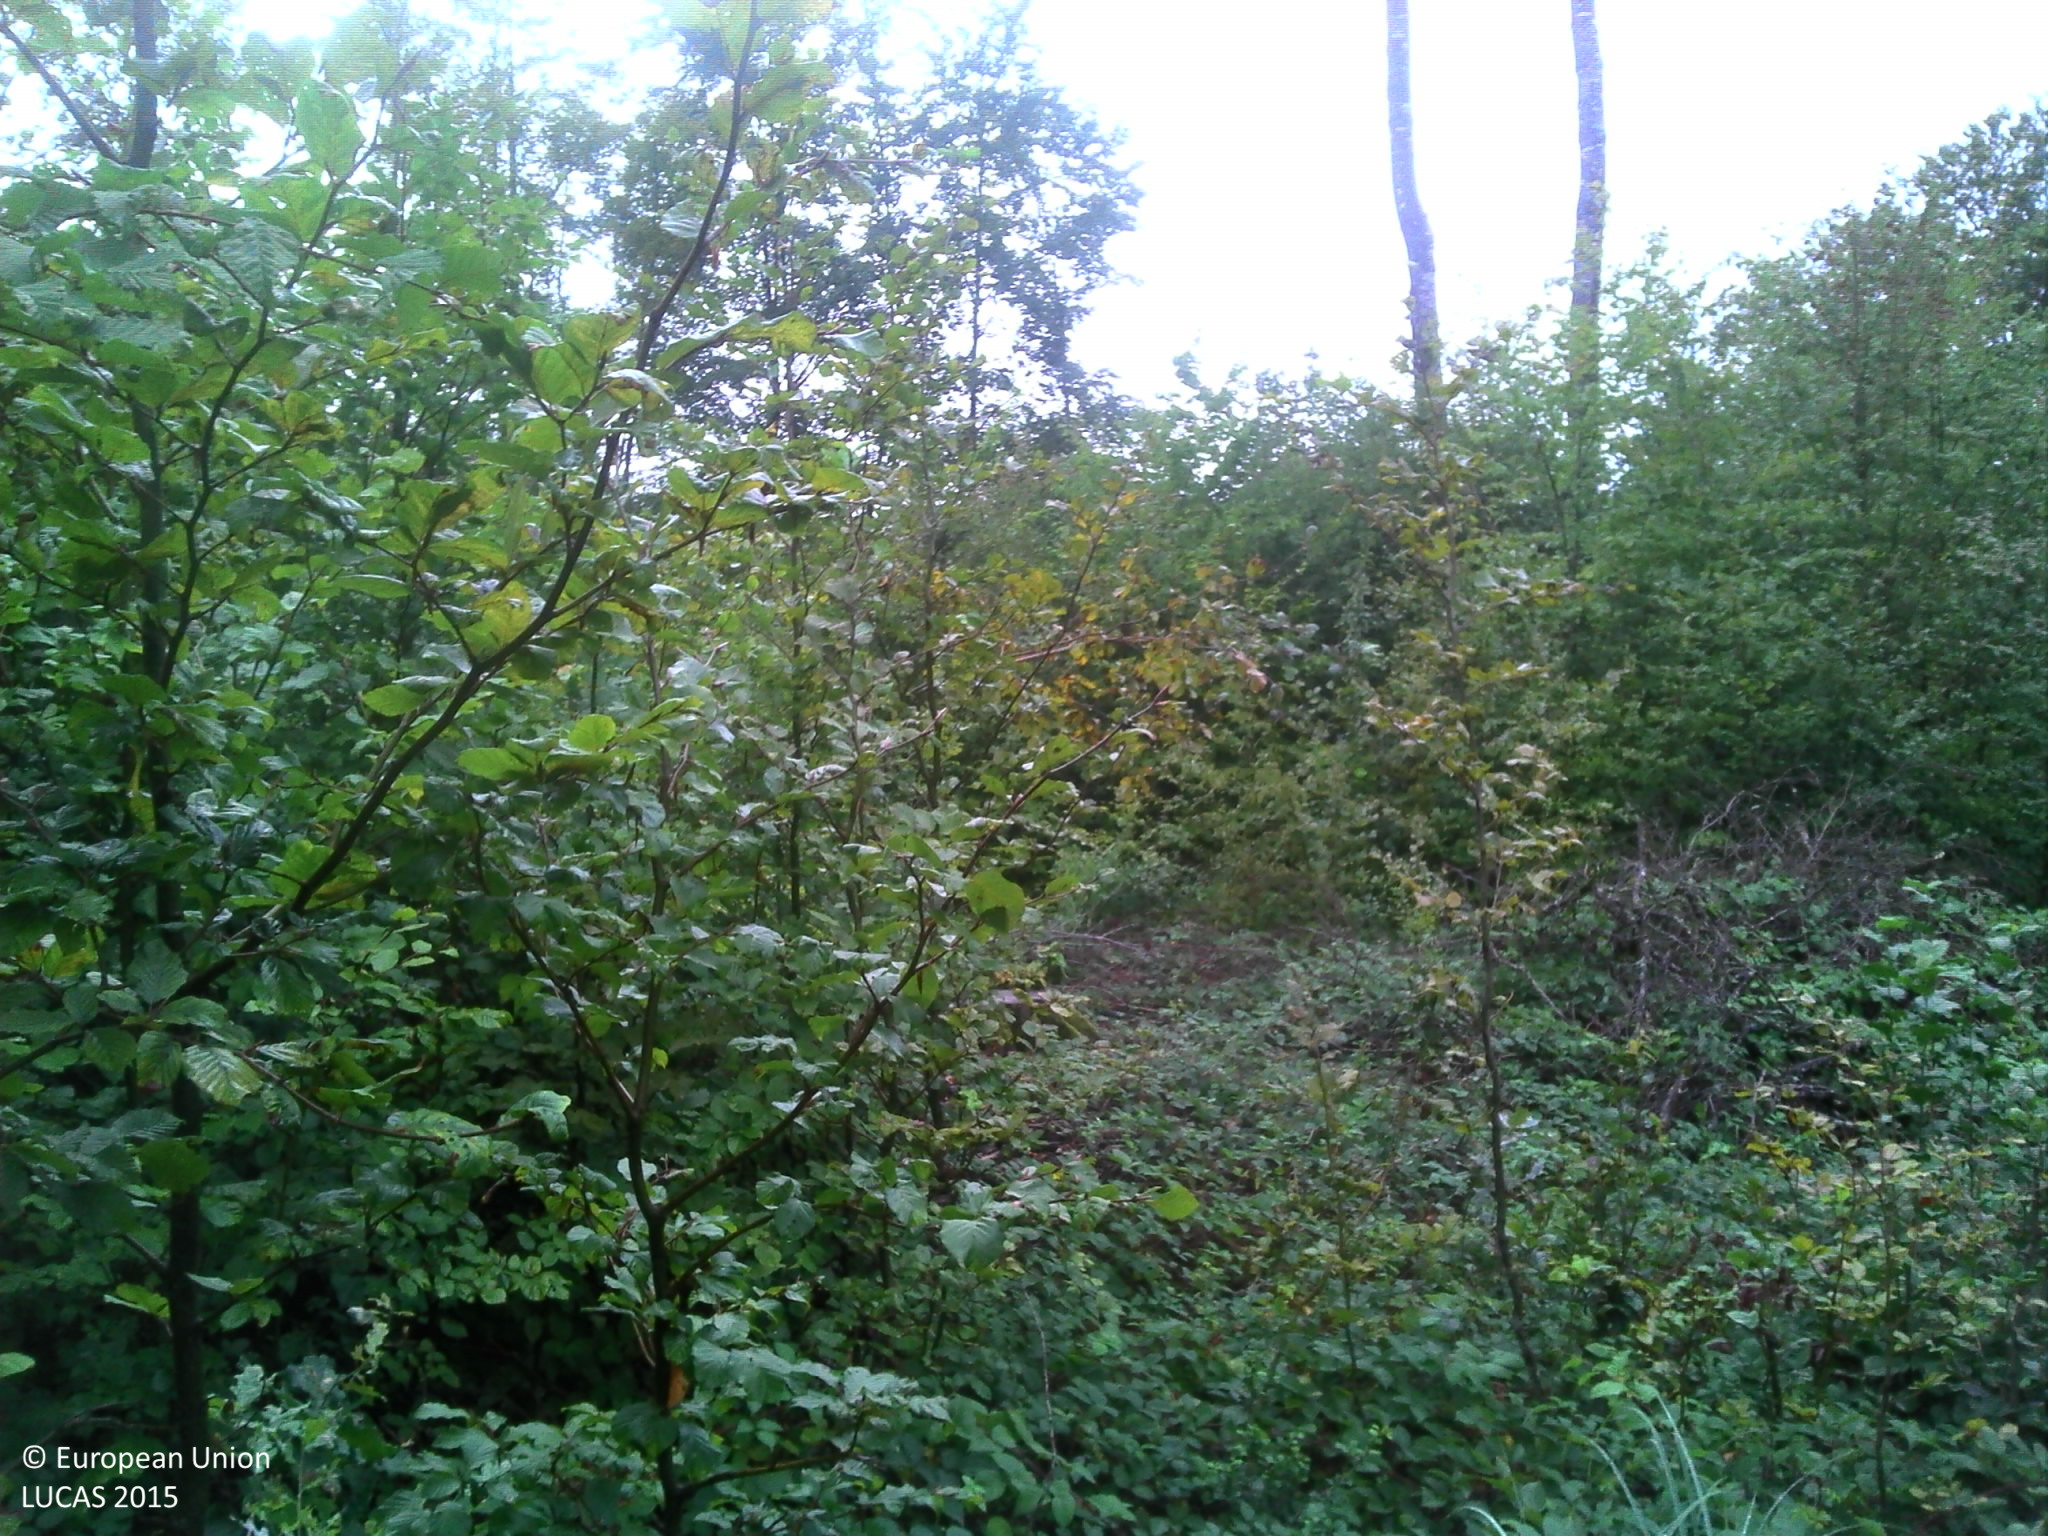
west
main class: Woodland
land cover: Broadleaved woodland
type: mesophytic deciduous forest
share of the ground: > 75 %
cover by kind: broadleaved forest trees 60 %, shrubs 20 %, herbaceous plants 10 %, consolidated bare surface 10 %
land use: Forestry
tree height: < 5 m
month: September
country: FR
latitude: 47.1694
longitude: 6.2684
